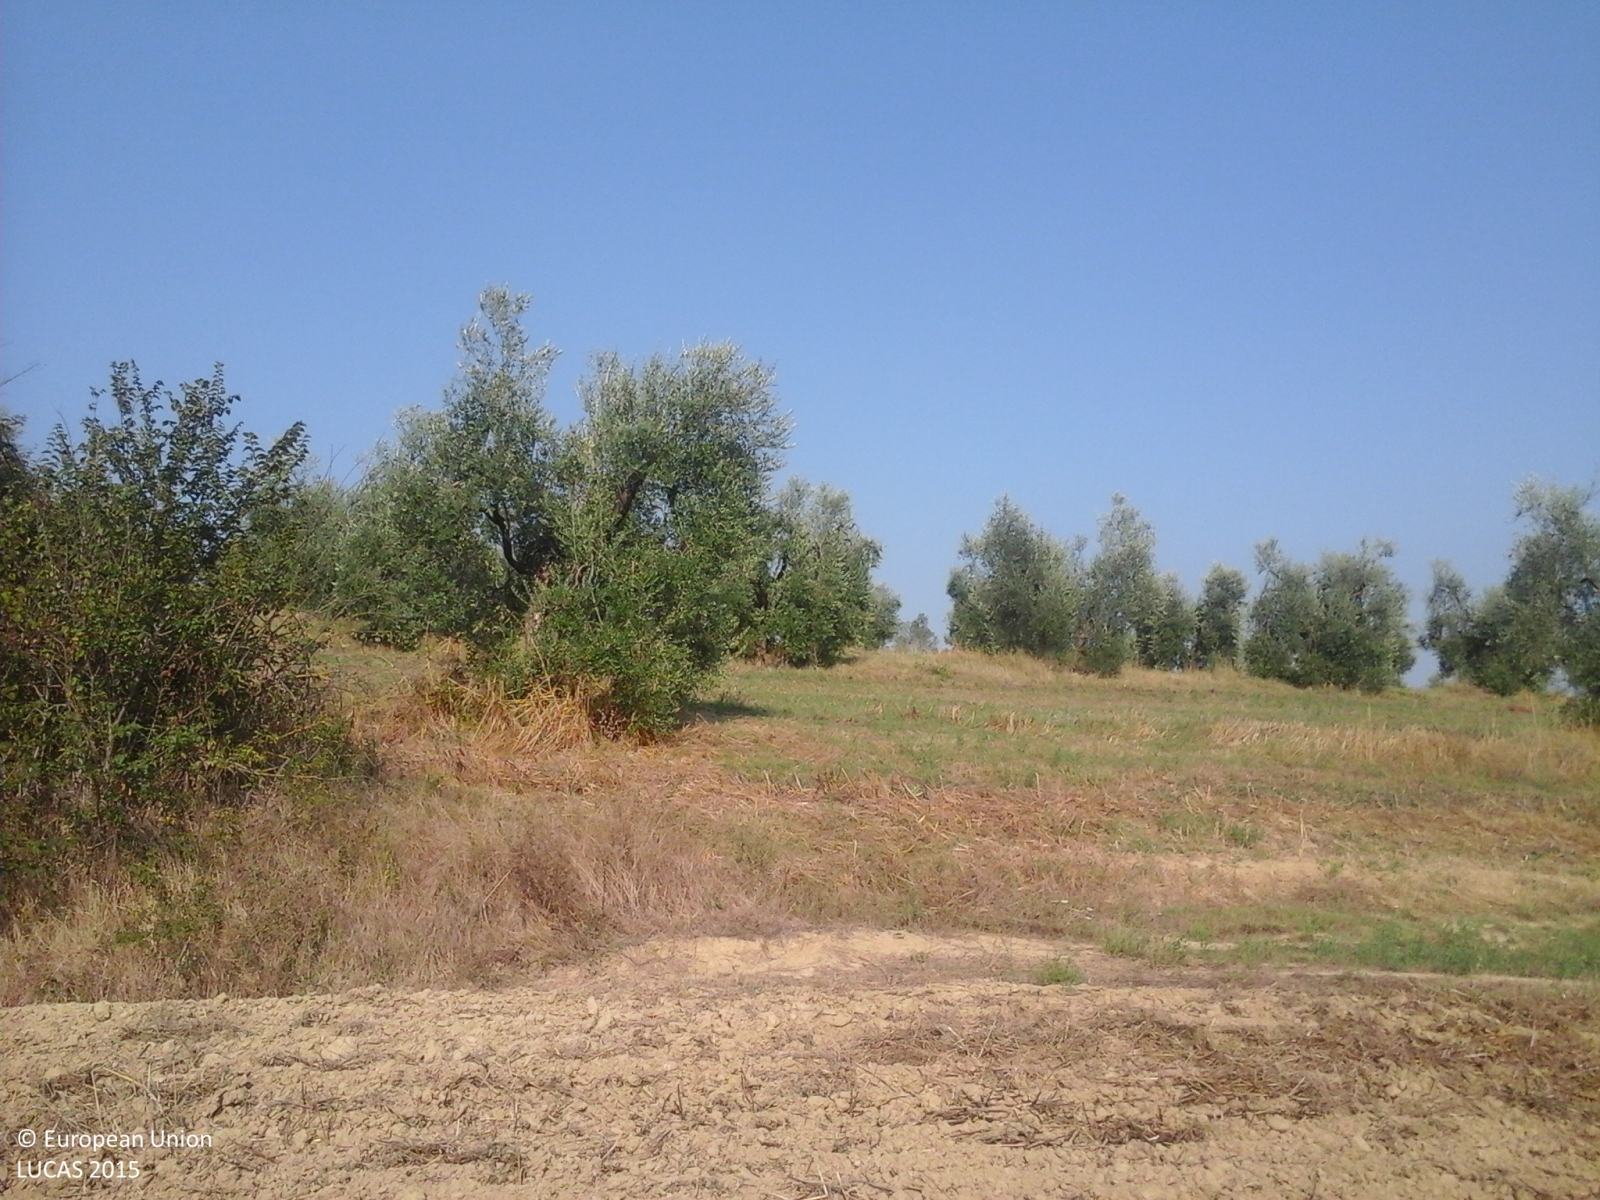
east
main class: Cropland
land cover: Sunflower
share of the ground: 10 - 25 %
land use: Agriculture (excluding fallow land and kitchen gardens)
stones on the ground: < 10 %
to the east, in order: Sunflower; Other leguminous and mixtures for fodder; Olive groves; Grass margins; Tracks; Ditches and canals; Olive groves; Common wheat
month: August
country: IT
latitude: 42.5377
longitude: 12.2937
